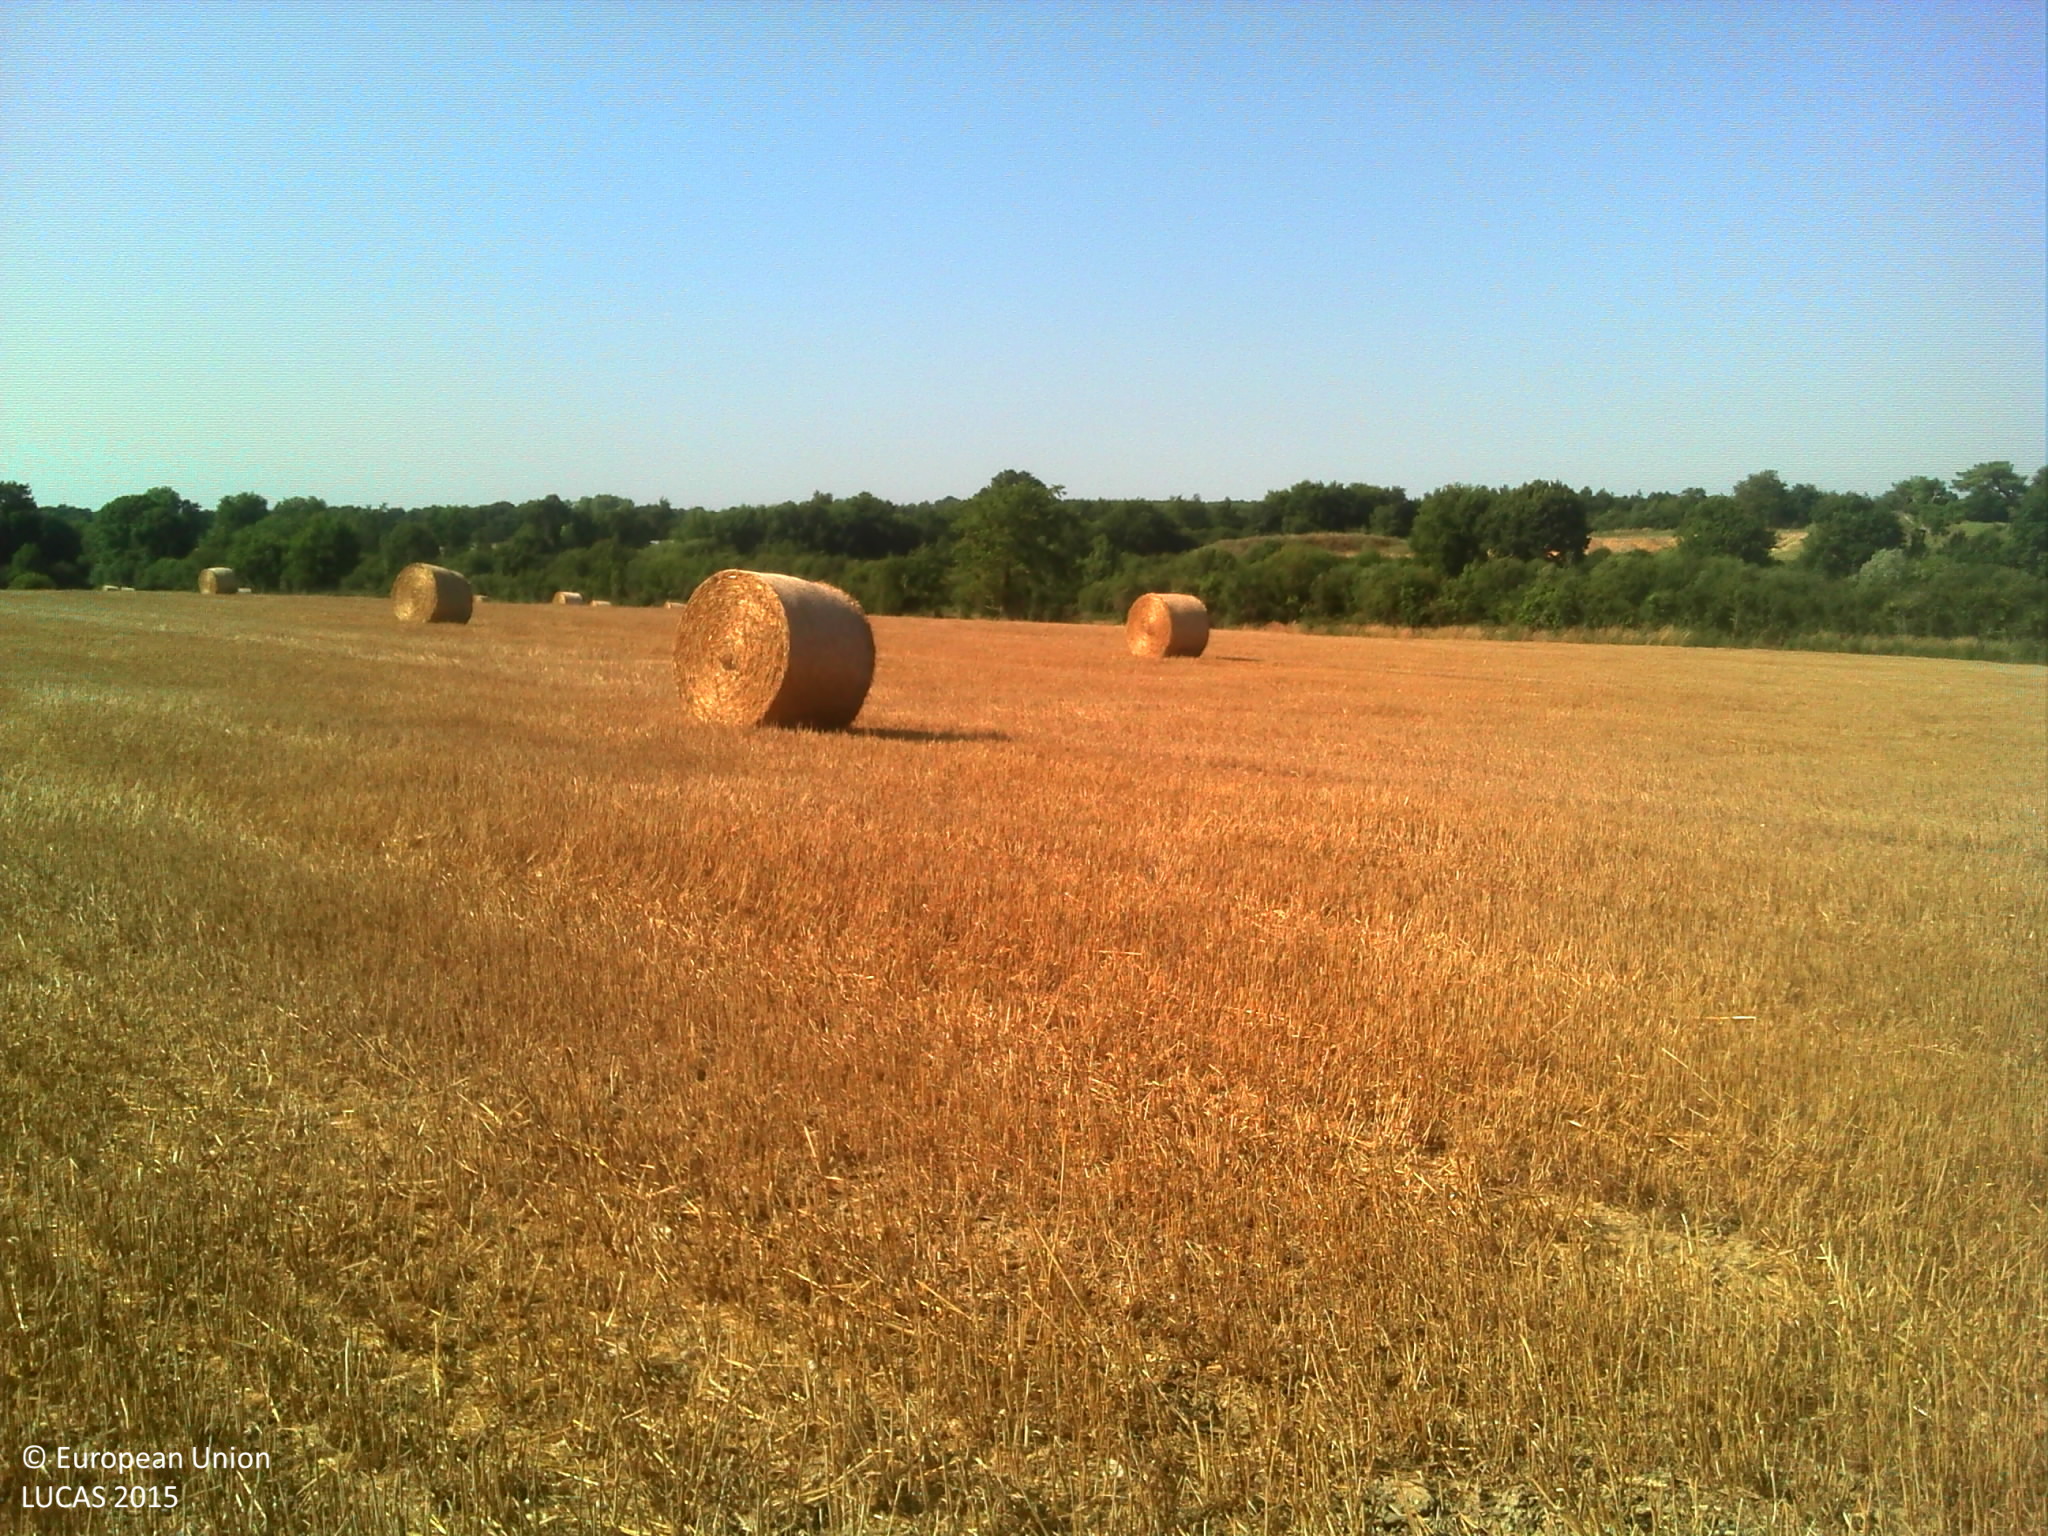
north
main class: Cropland
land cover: Common wheat
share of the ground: > 75 %
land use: Agriculture (excluding fallow land and kitchen gardens)
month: July
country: FR
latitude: 46.5506
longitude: -1.6344
